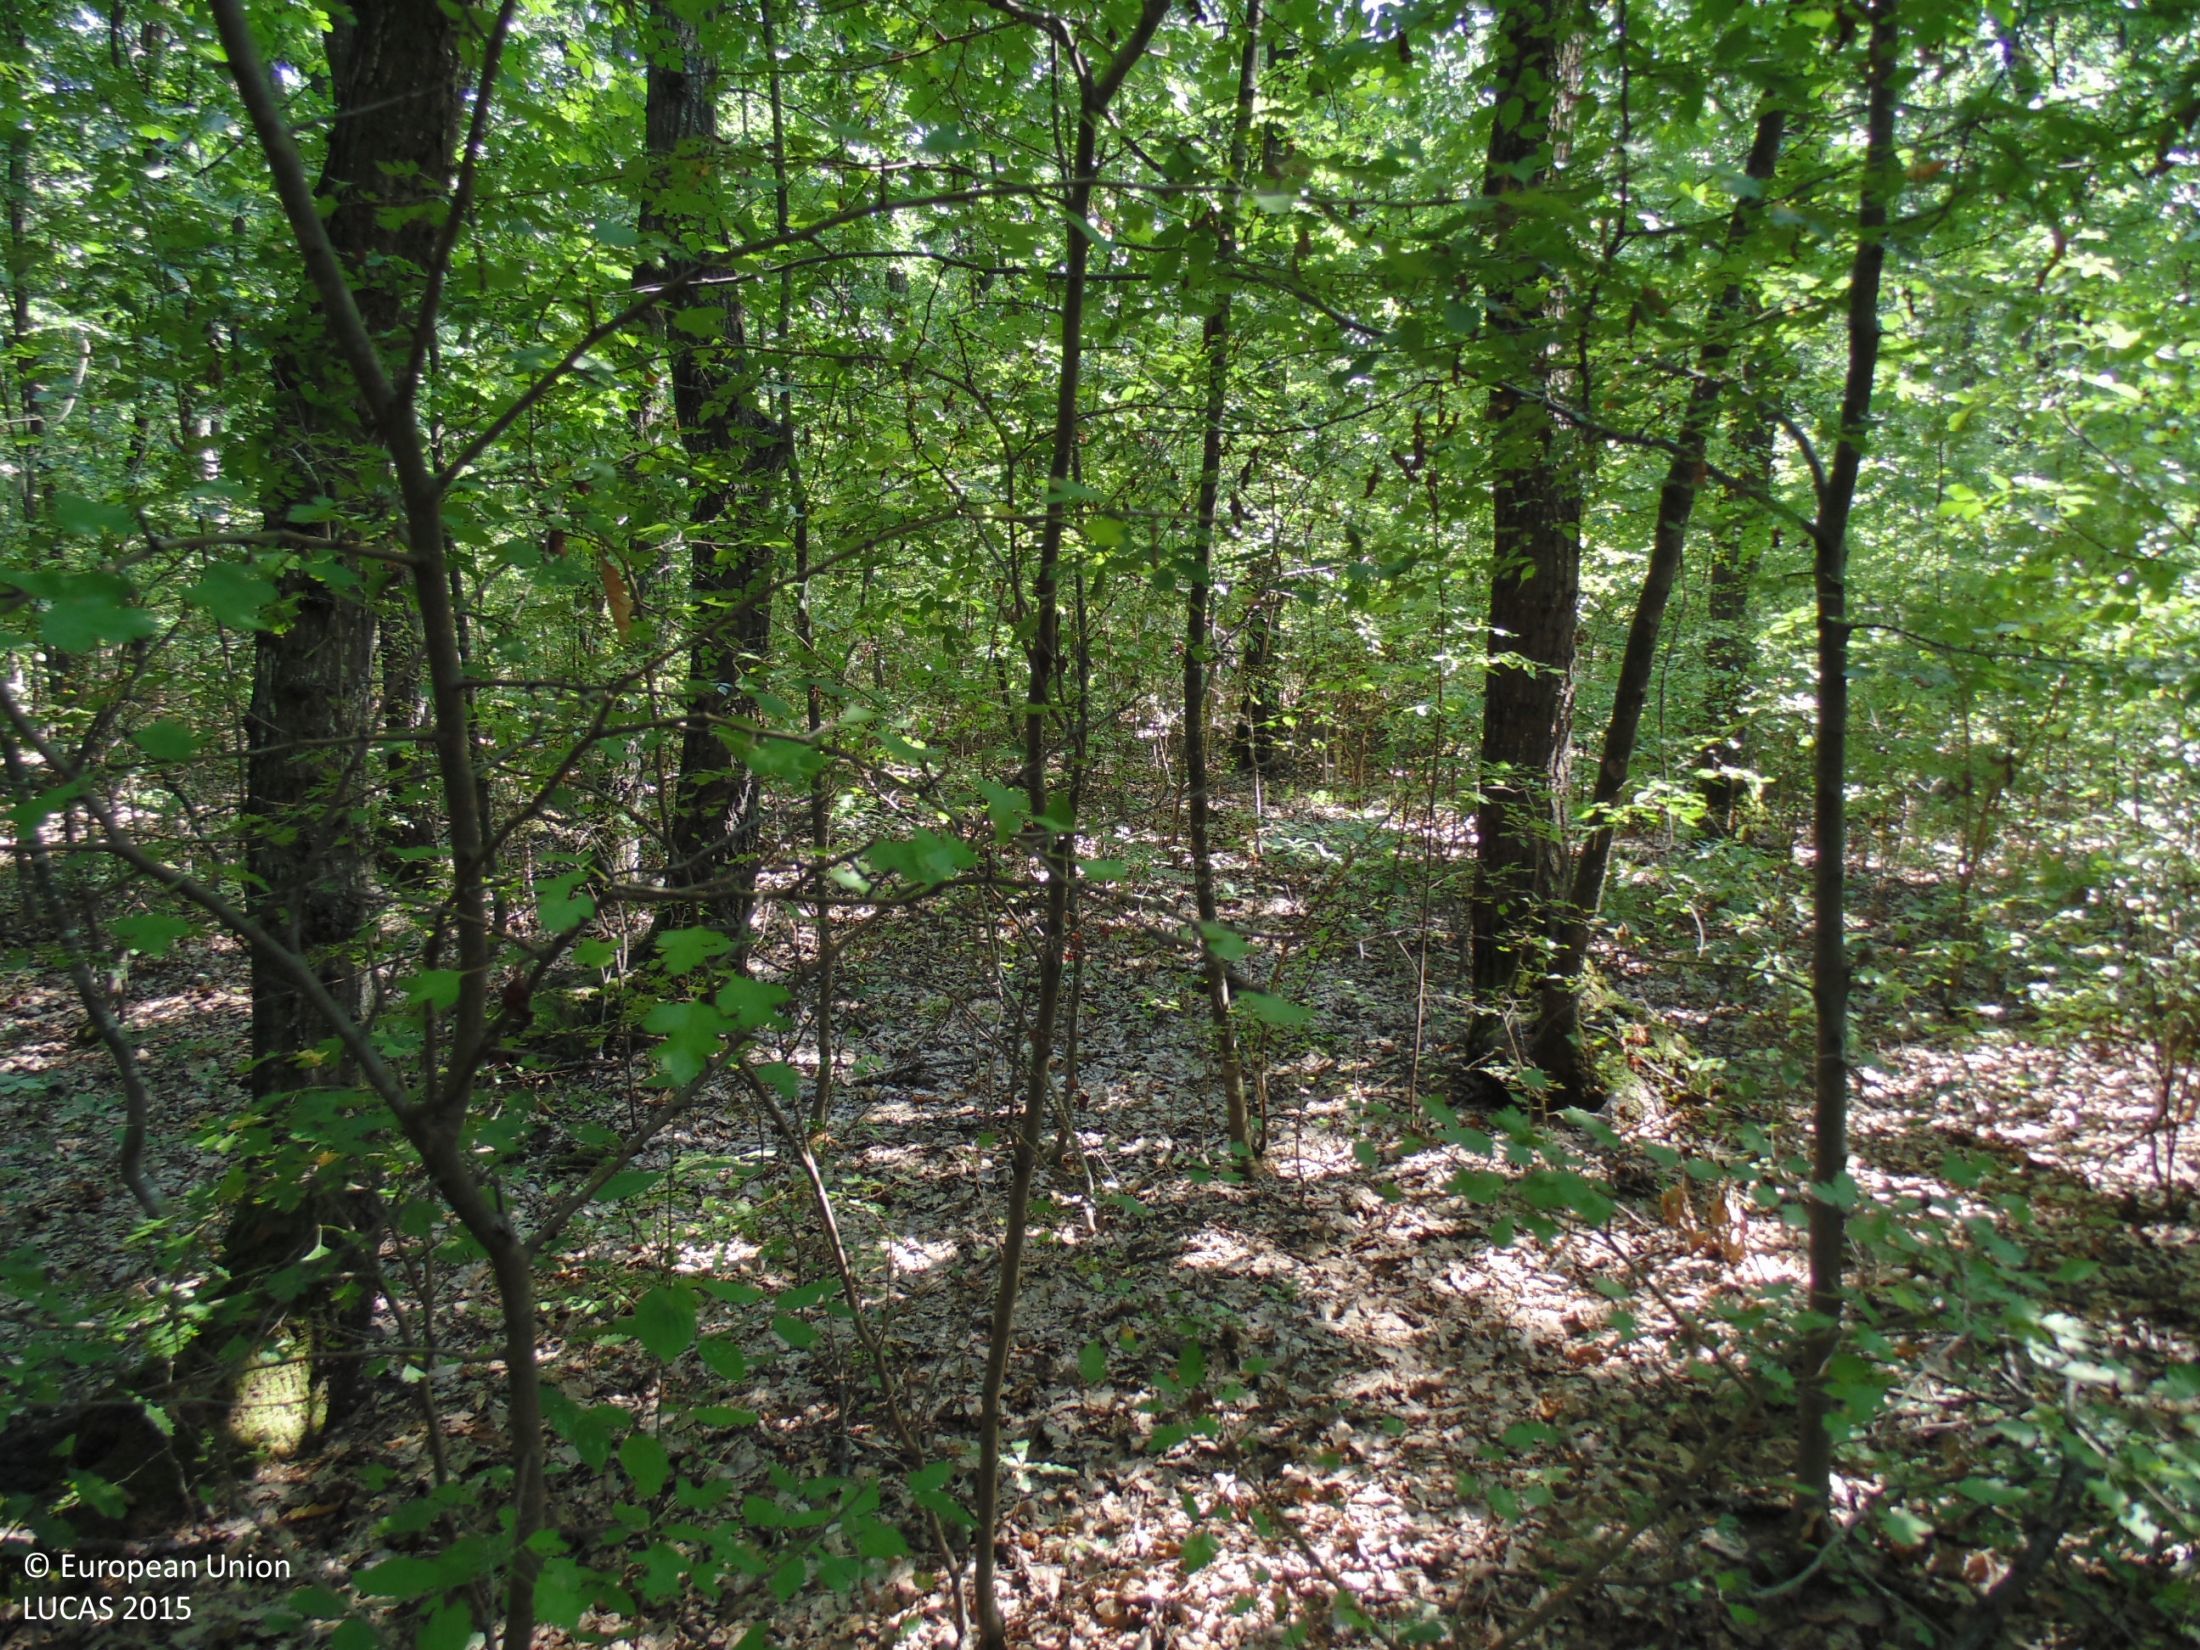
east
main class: Woodland
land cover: Broadleaved woodland
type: mesophytic deciduous forest
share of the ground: > 75 %
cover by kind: broadleaved forest trees 95 %, unconsolidated bare surface 5 %
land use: Forestry
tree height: > 5 m
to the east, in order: Broadleaved woodland; Grass margins; Tracks; Grass margins; Common wheat
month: August
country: BG
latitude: 43.9504
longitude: 27.4169
